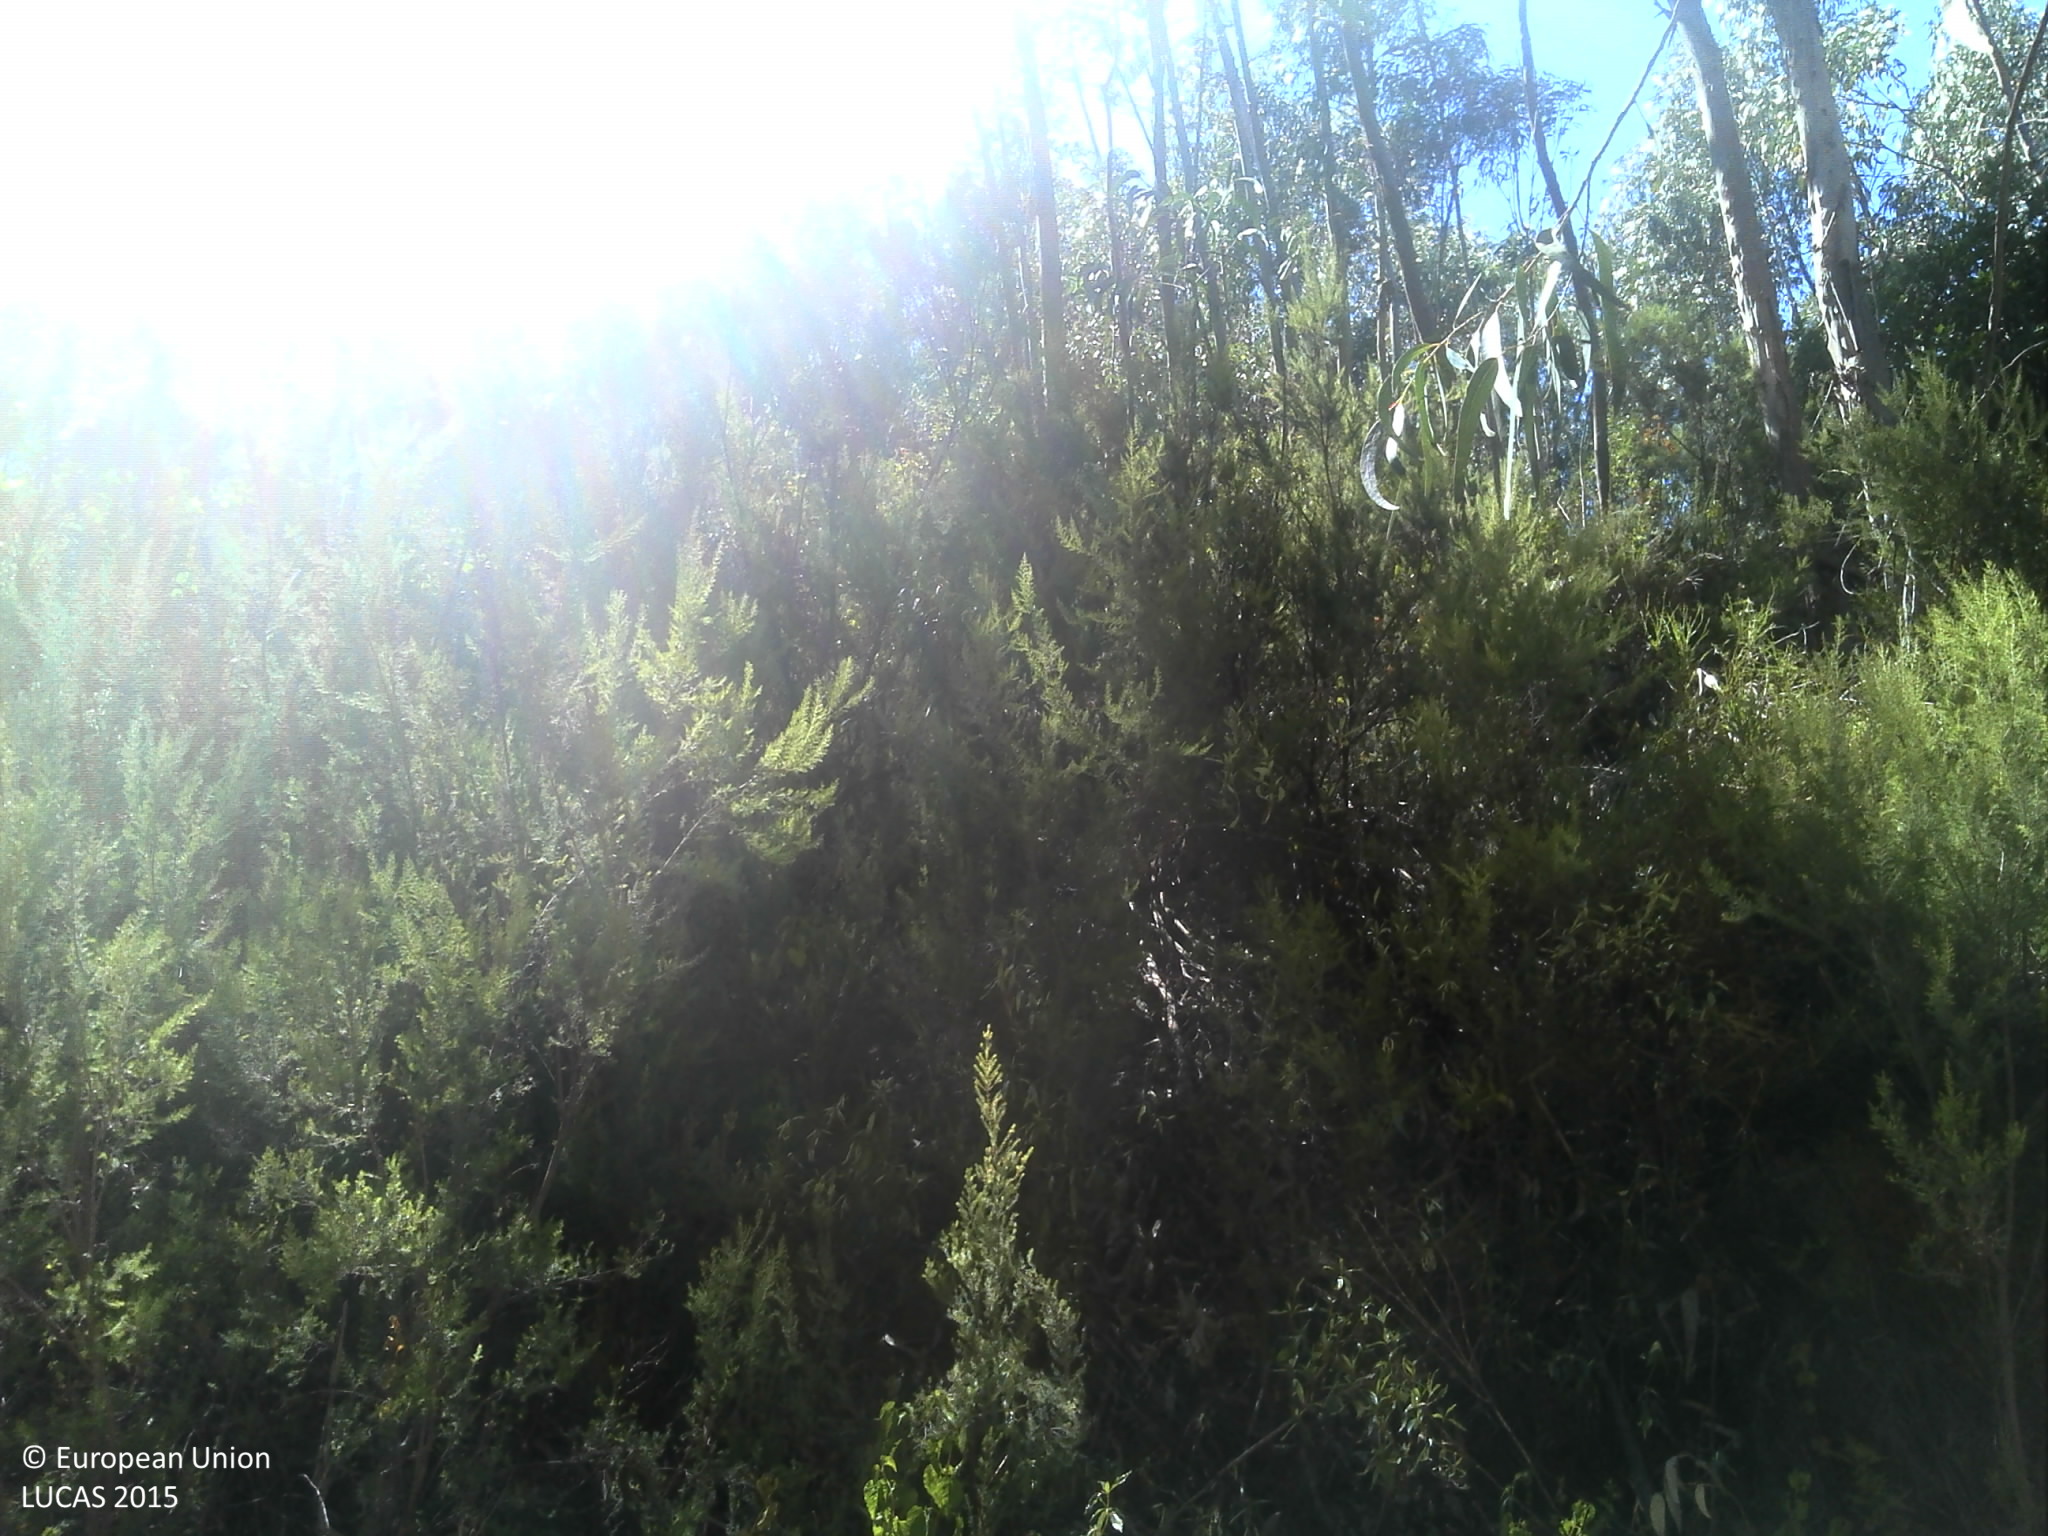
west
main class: Shrubland
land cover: Shrubland with sparse tree cover
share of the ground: 50 - 75 %
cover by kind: shrubs 50 %, herbaceous plants 30 %, unconsolidated bare surface 15 %, broadleaved forest trees 5 %
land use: Forestry
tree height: > 5 m
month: August
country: PT
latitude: 37.2929
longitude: -8.6558
